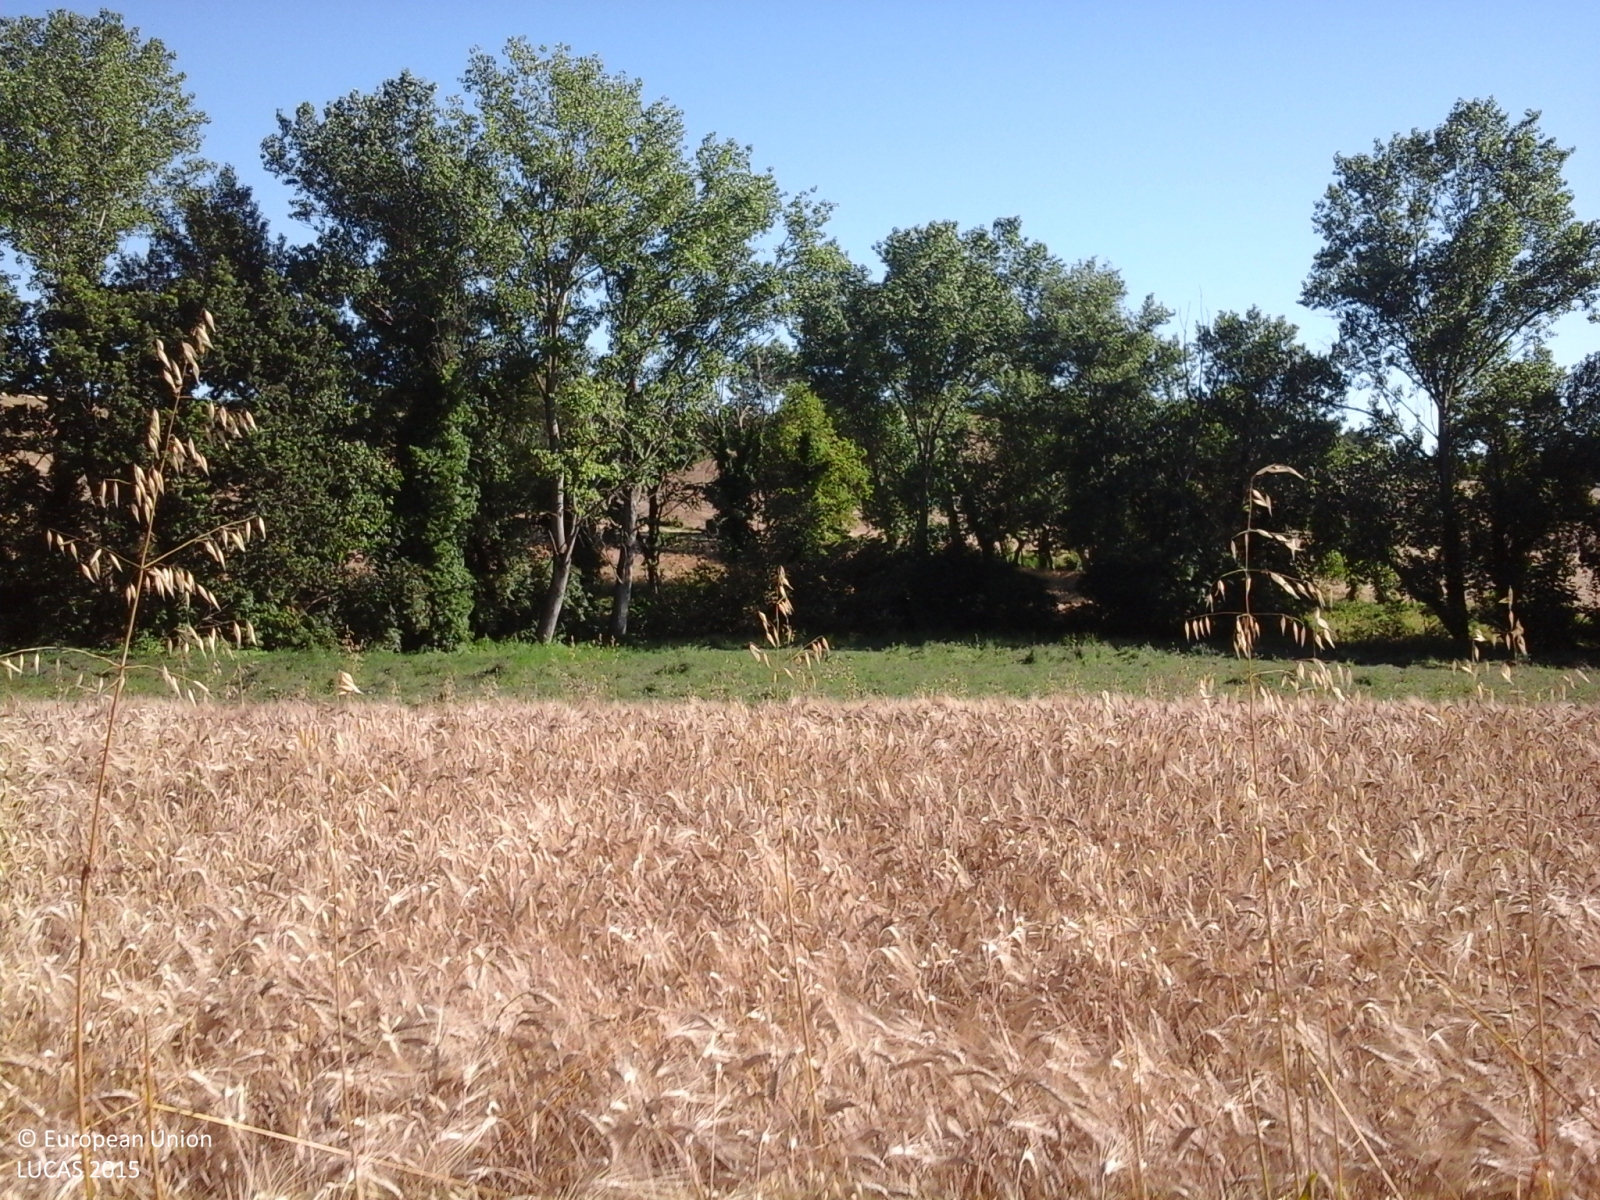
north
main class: Cropland
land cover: Durum wheat
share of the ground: > 75 %
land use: Agriculture (excluding fallow land and kitchen gardens)
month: June
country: IT
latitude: 43.3744
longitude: 13.3855
